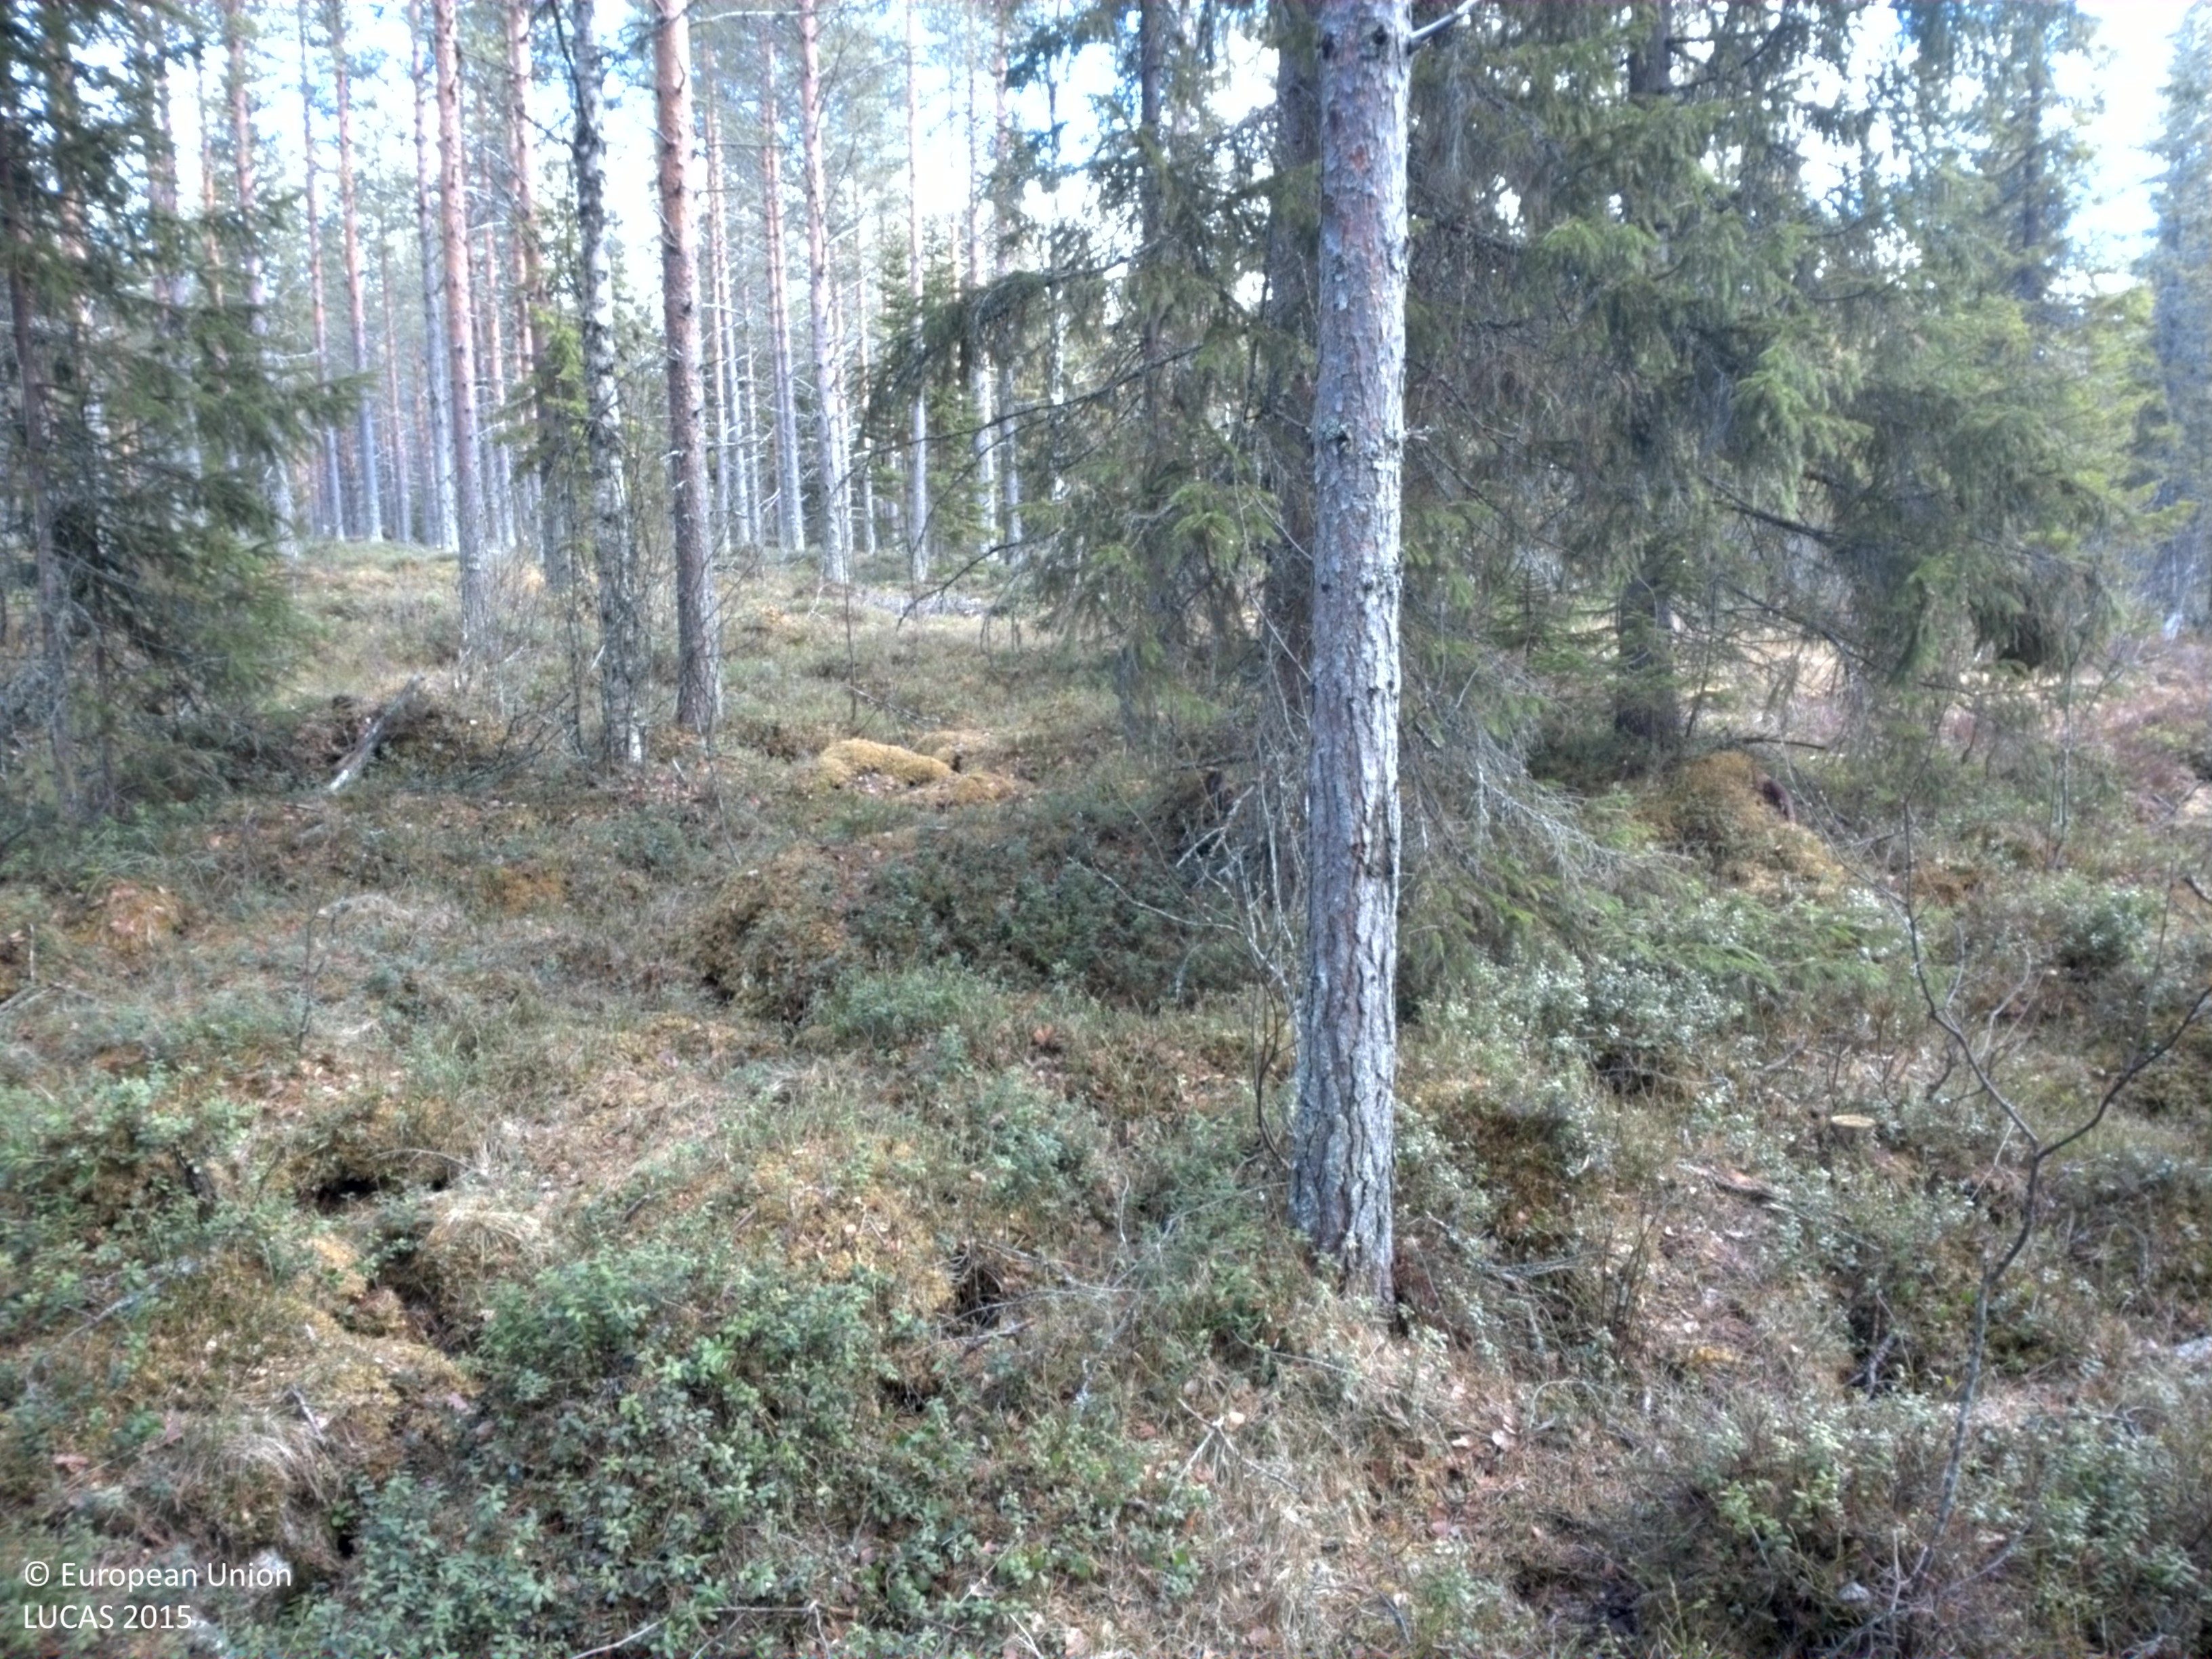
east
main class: Woodland
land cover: Pine dominated coniferous woodland
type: boreal forest
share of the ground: 50 - 75 %
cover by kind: coniferous forest trees 60 %, herbaceous plants 30 %, broadleaved forest trees 5 %, lichens and mosses 5 %
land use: Forestry
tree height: > 5 m
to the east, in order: Pine dominated coniferous woodland; Spruce dominated coniferous woodland; Pine dominated coniferous woodland
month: May
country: SE
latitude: 64.2631
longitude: 17.7503
